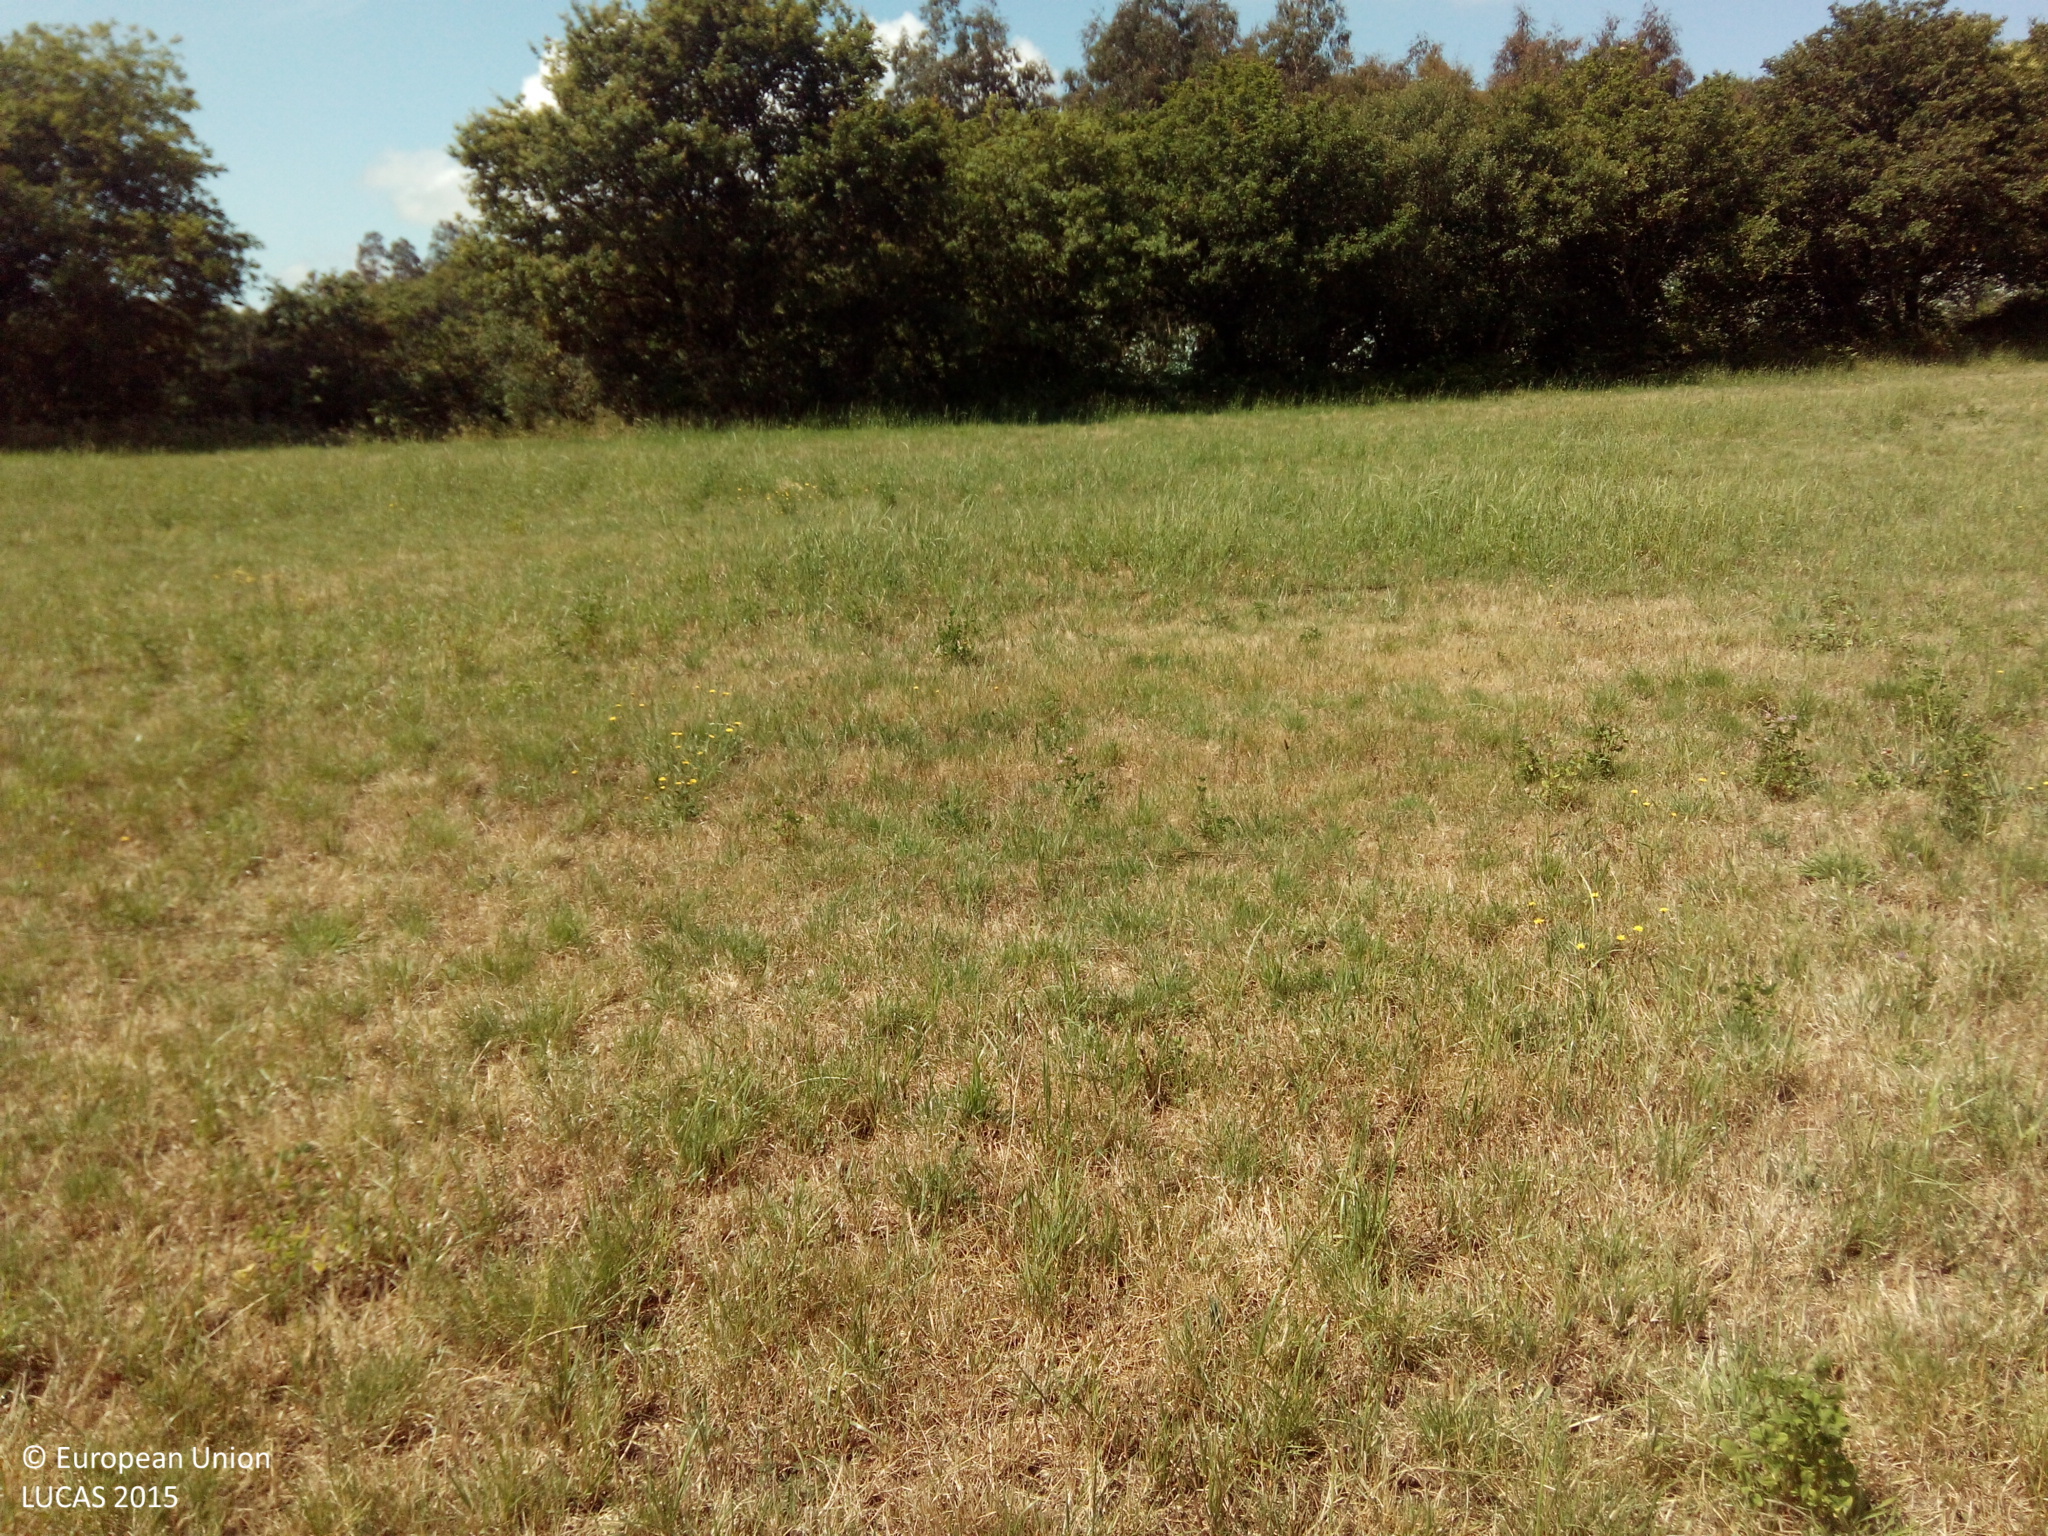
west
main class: Cropland
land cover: Temporary grasslands
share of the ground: 50 - 75 %
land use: Agriculture (excluding fallow land and kitchen gardens)
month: July
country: ES
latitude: 42.9894
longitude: -7.9580
